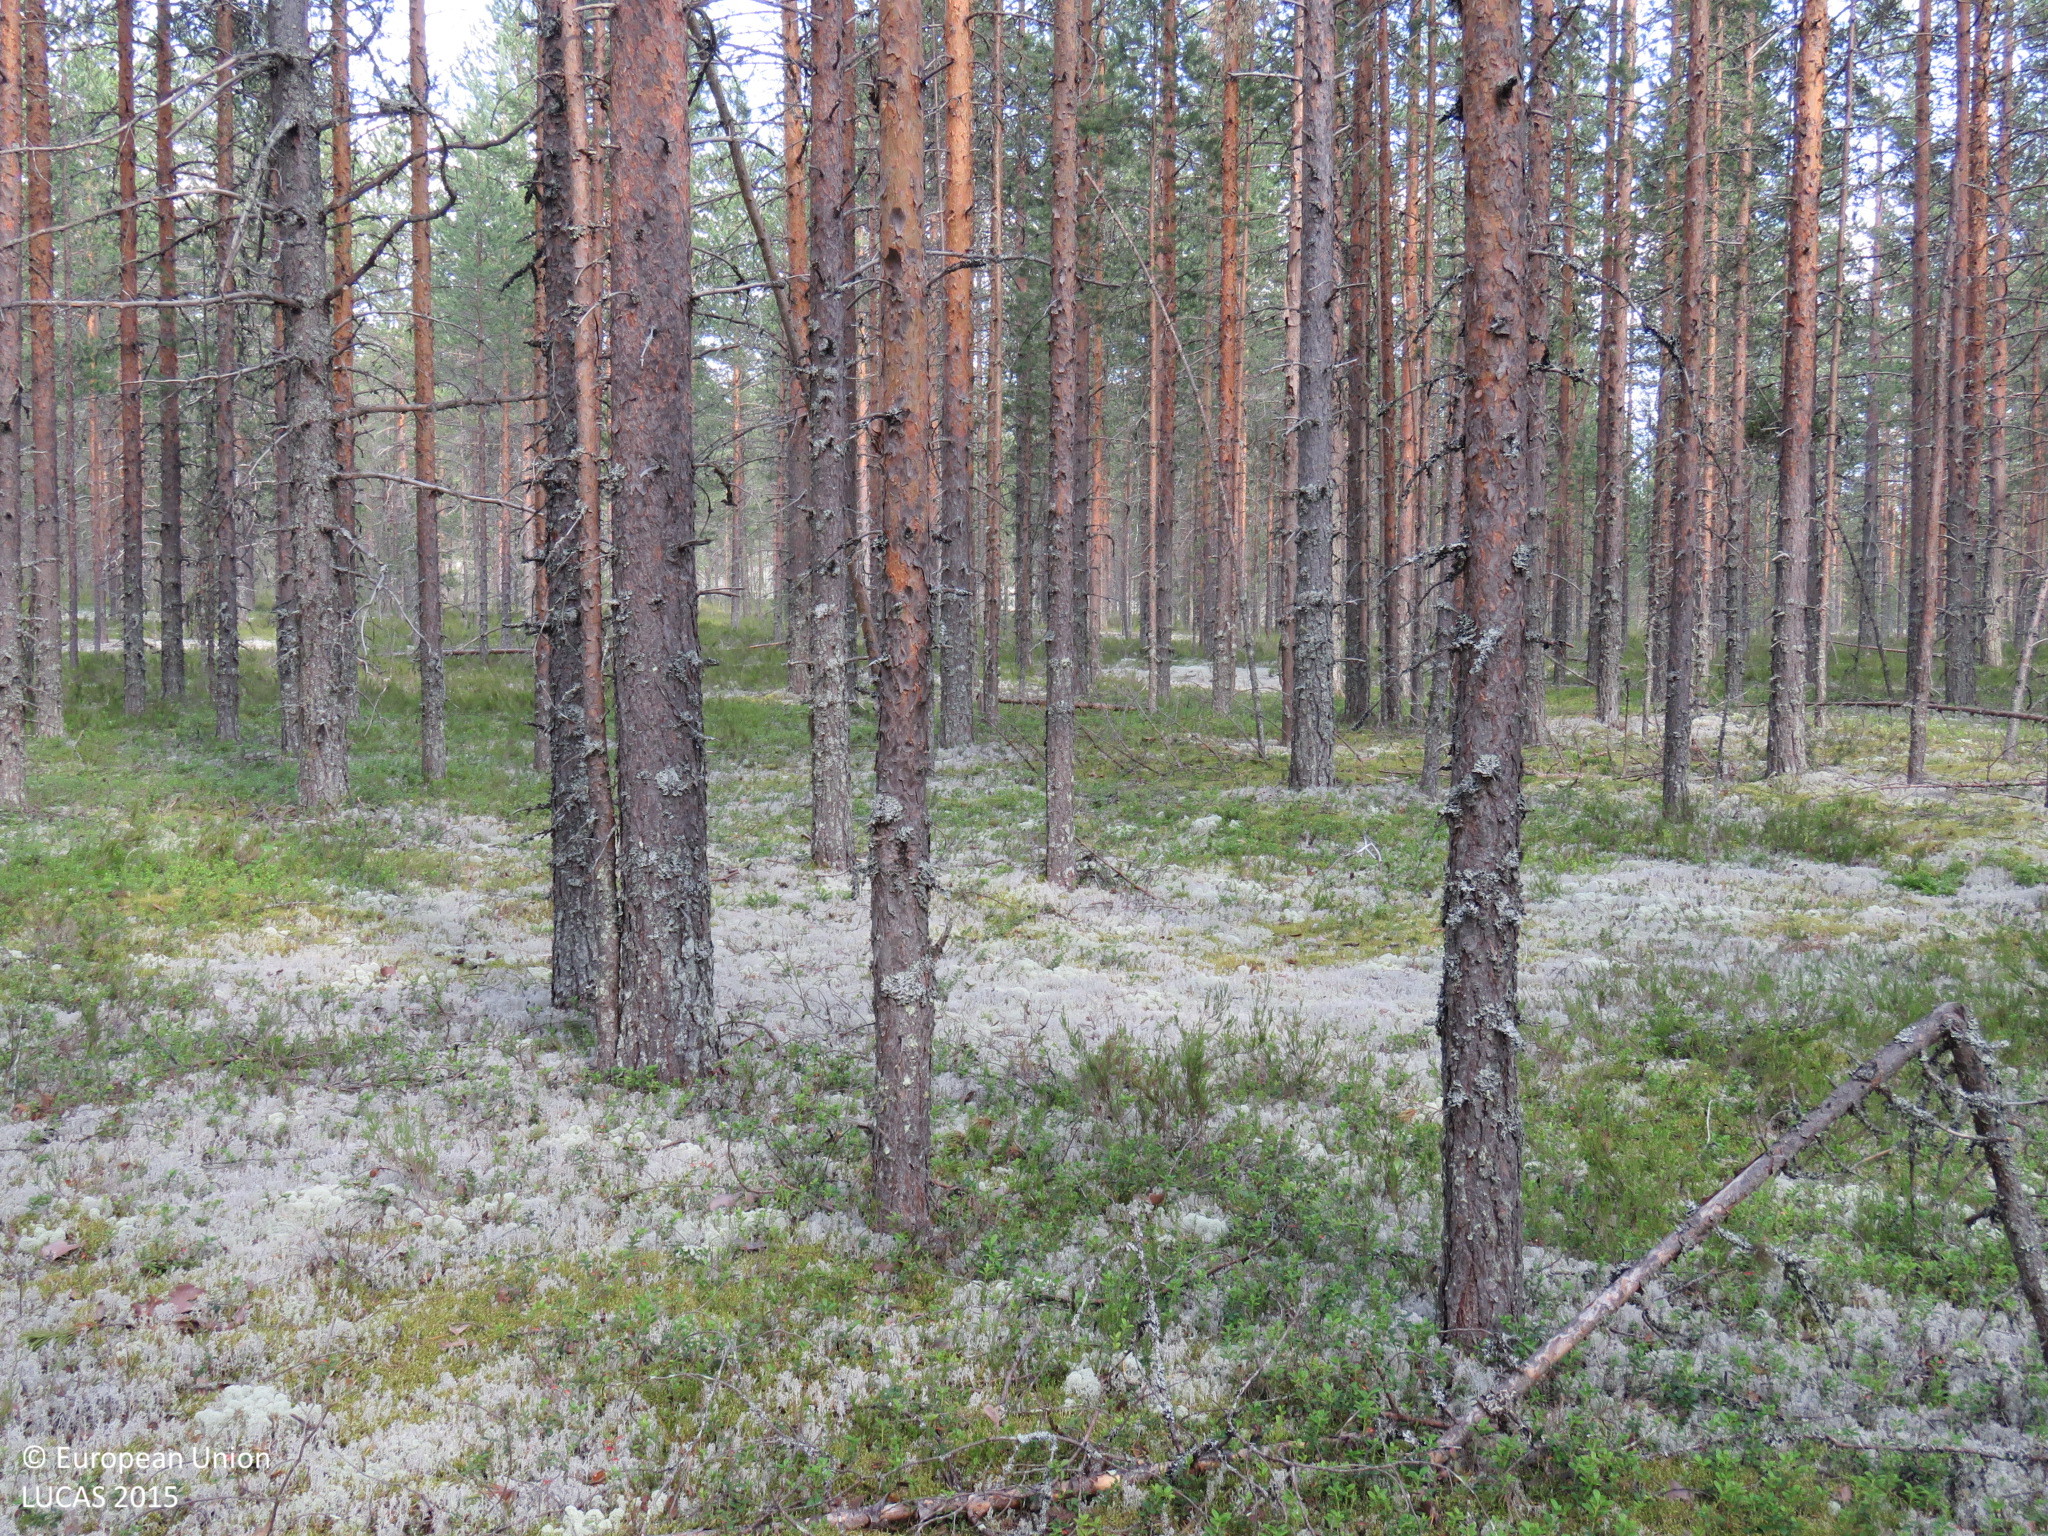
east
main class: Woodland
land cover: Pine dominated coniferous woodland
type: boreal forest
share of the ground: > 75 %
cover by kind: coniferous forest trees 80 %, shrubs 10 %, lichens and mosses 10 %
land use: Amenities, museums, leisure
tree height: > 5 m
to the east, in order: Pine dominated coniferous woodland; Tracks; Pine dominated coniferous woodland; Paved roads, cycling and walking lanes; Pine dominated coniferous woodland
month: July
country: FI
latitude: 64.5860
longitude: 26.4648
